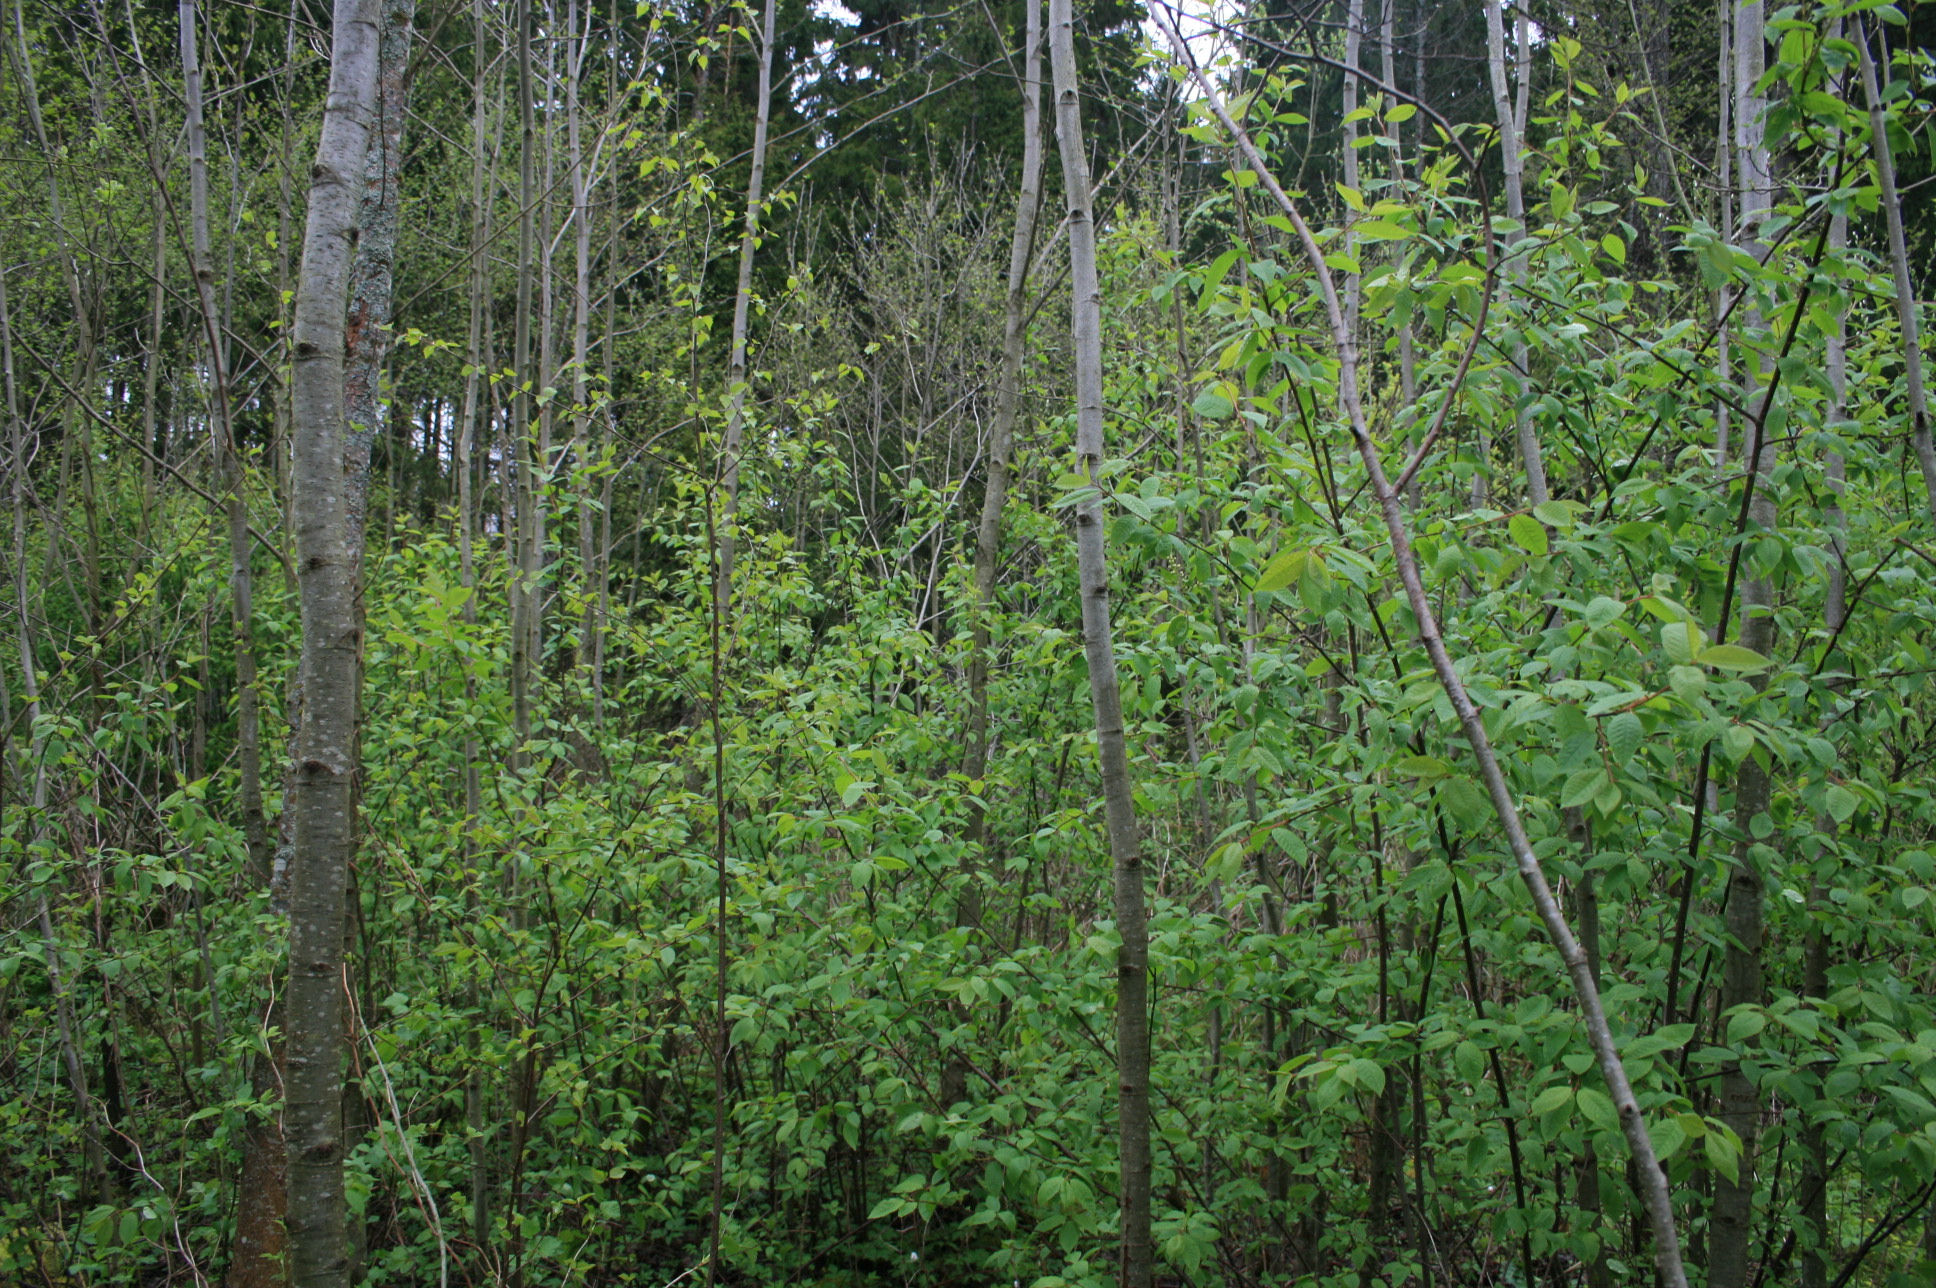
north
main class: Woodland
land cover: Broadleaved woodland
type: non-riverine alder, birch or aspen forest
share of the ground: 50 - 75 %
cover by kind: broadleaved forest trees 70 %, shrubs 20 %, herbaceous plants 10 %
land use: Forestry
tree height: > 5 m
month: May
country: LT
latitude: 56.3758
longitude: 22.1150
